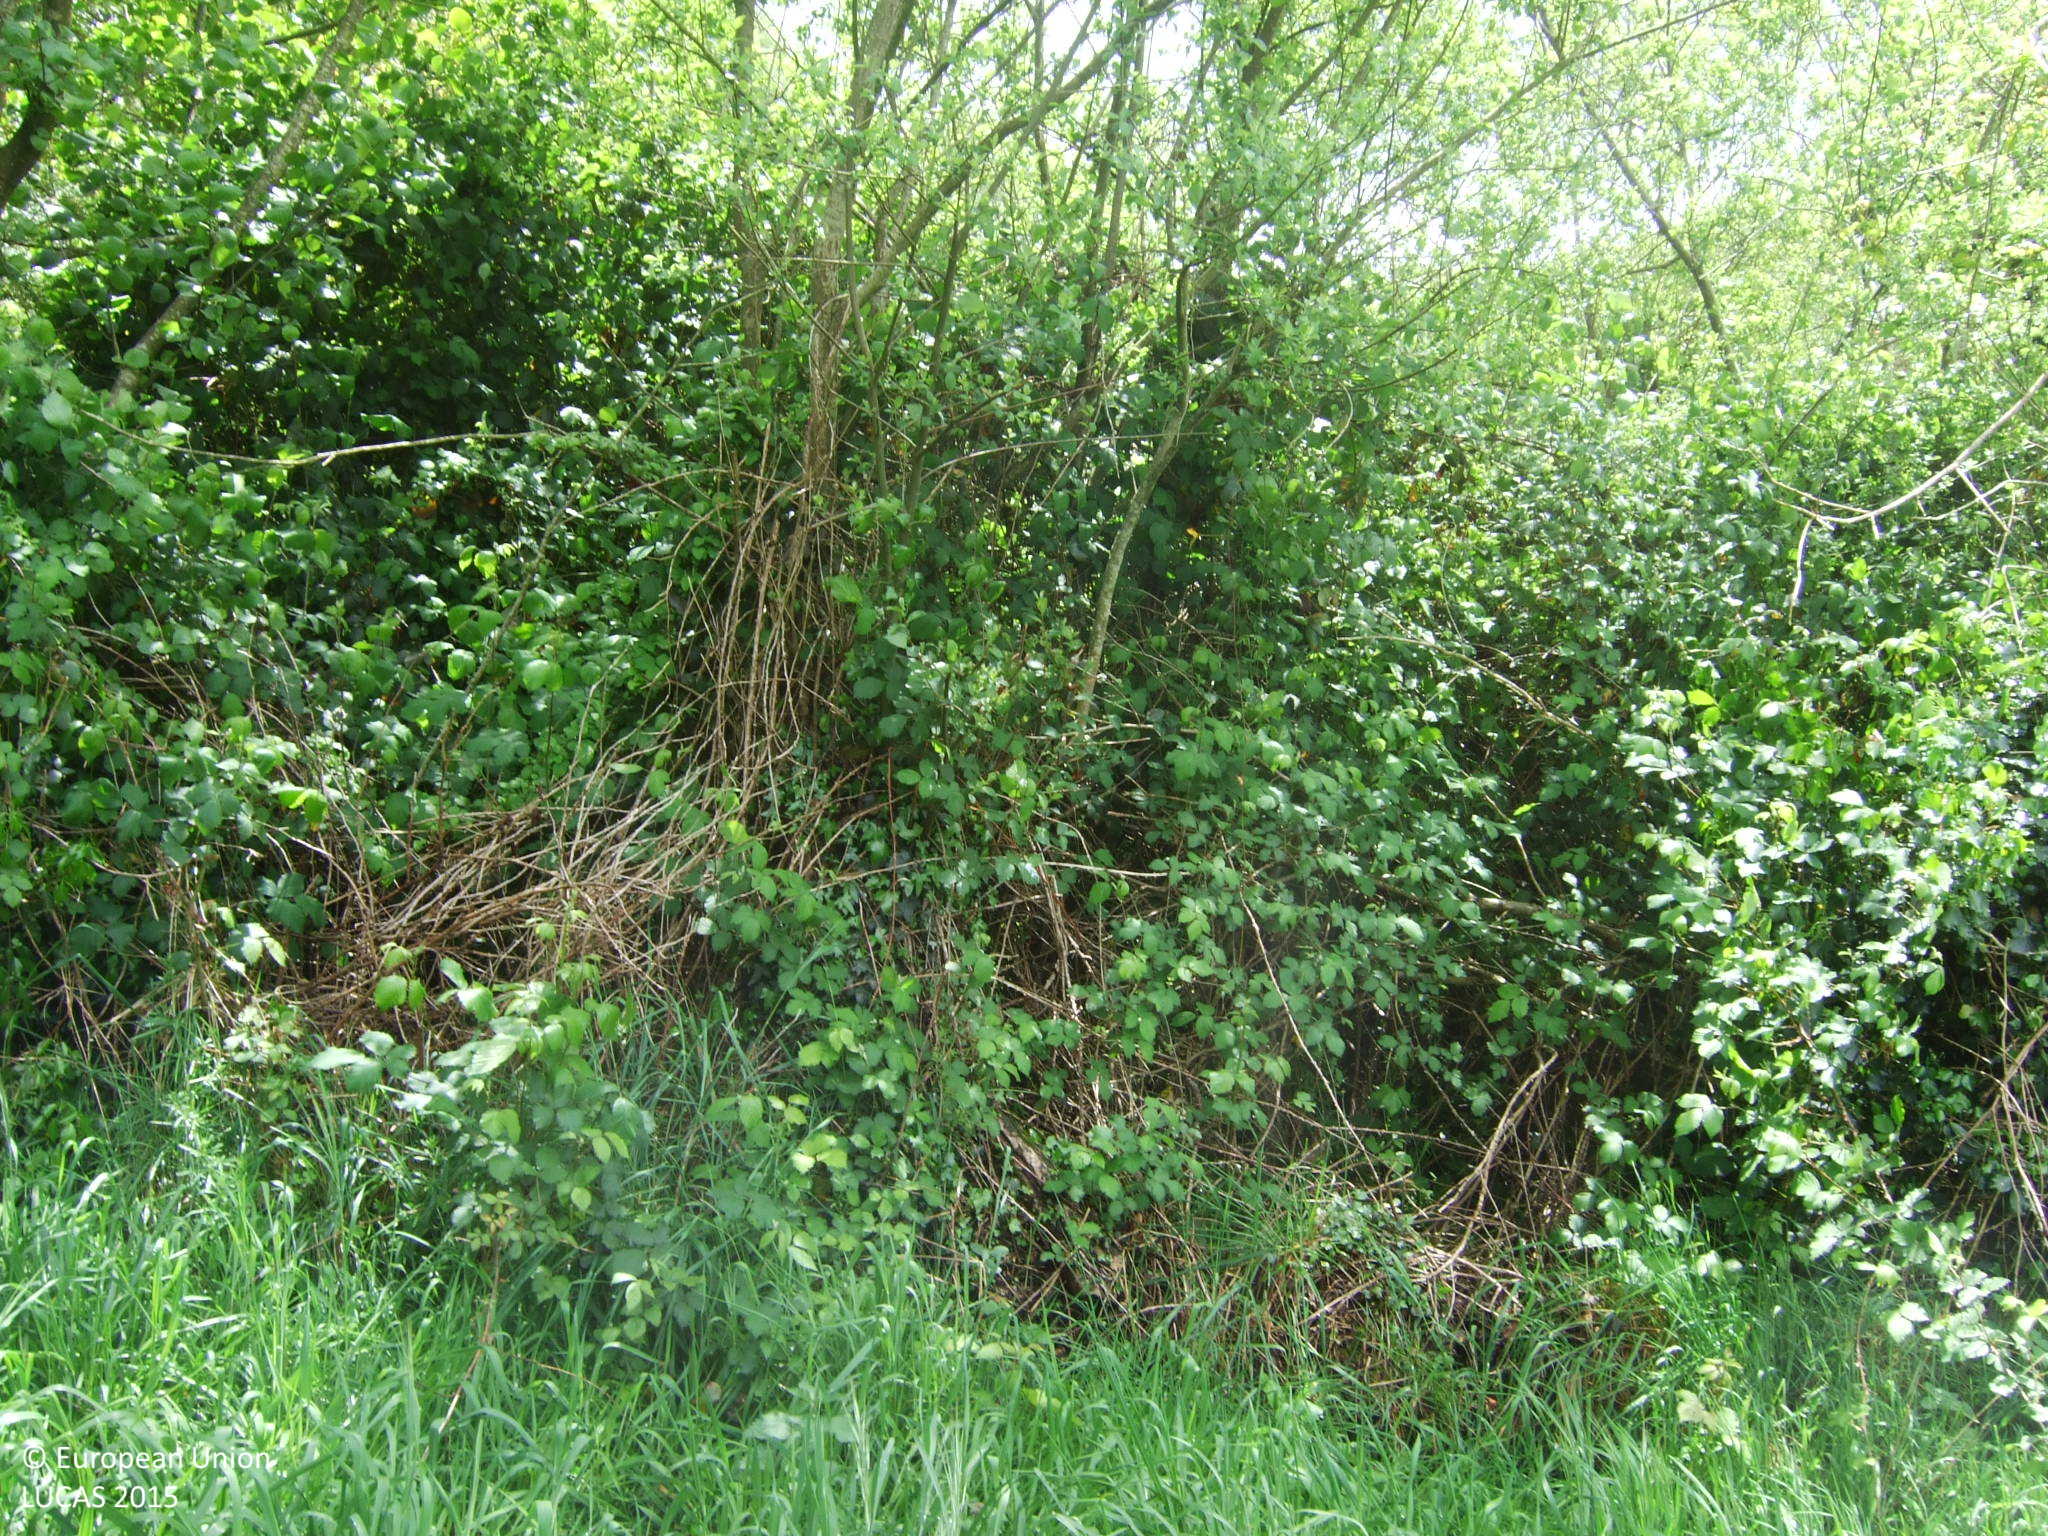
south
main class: Grassland
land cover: Grassland without tree/shrub cover
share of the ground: > 75 %
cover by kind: herbaceous plants 100 %
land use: Agriculture (excluding fallow land and kitchen gardens)
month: May
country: ES
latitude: 42.7997
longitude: -7.5720
